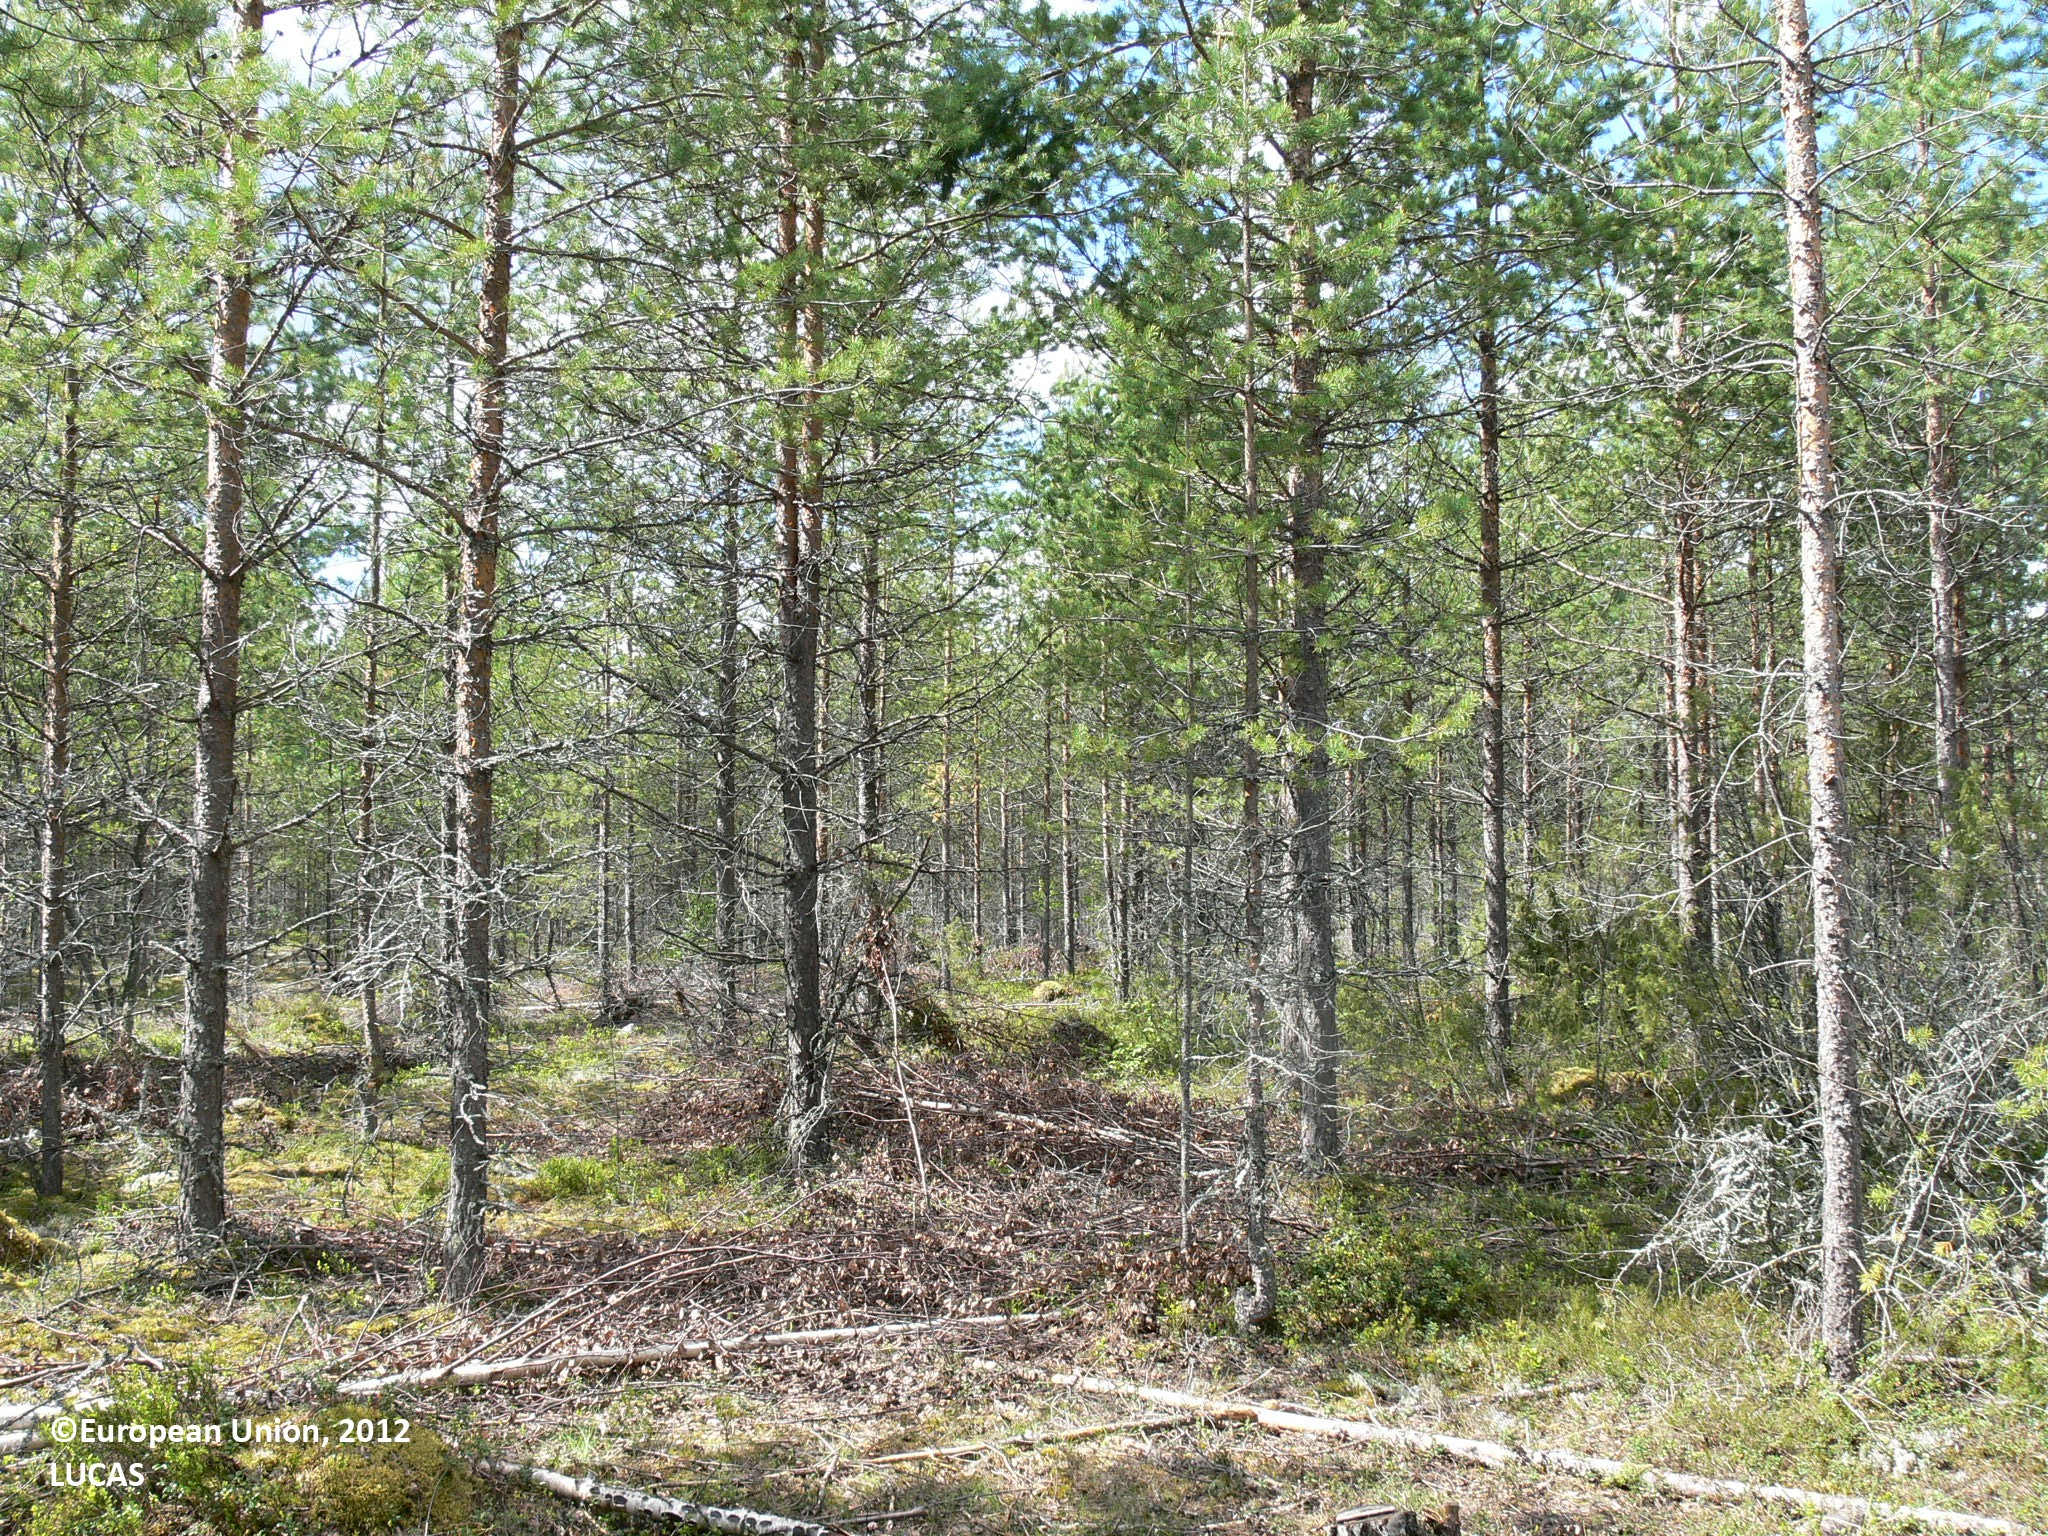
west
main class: Woodland
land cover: Pine dominated mixed woodland
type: boreal forest
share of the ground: > 75 %
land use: Forestry
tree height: < 5 m
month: June
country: FI
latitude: 62.6834
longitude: 29.7611
